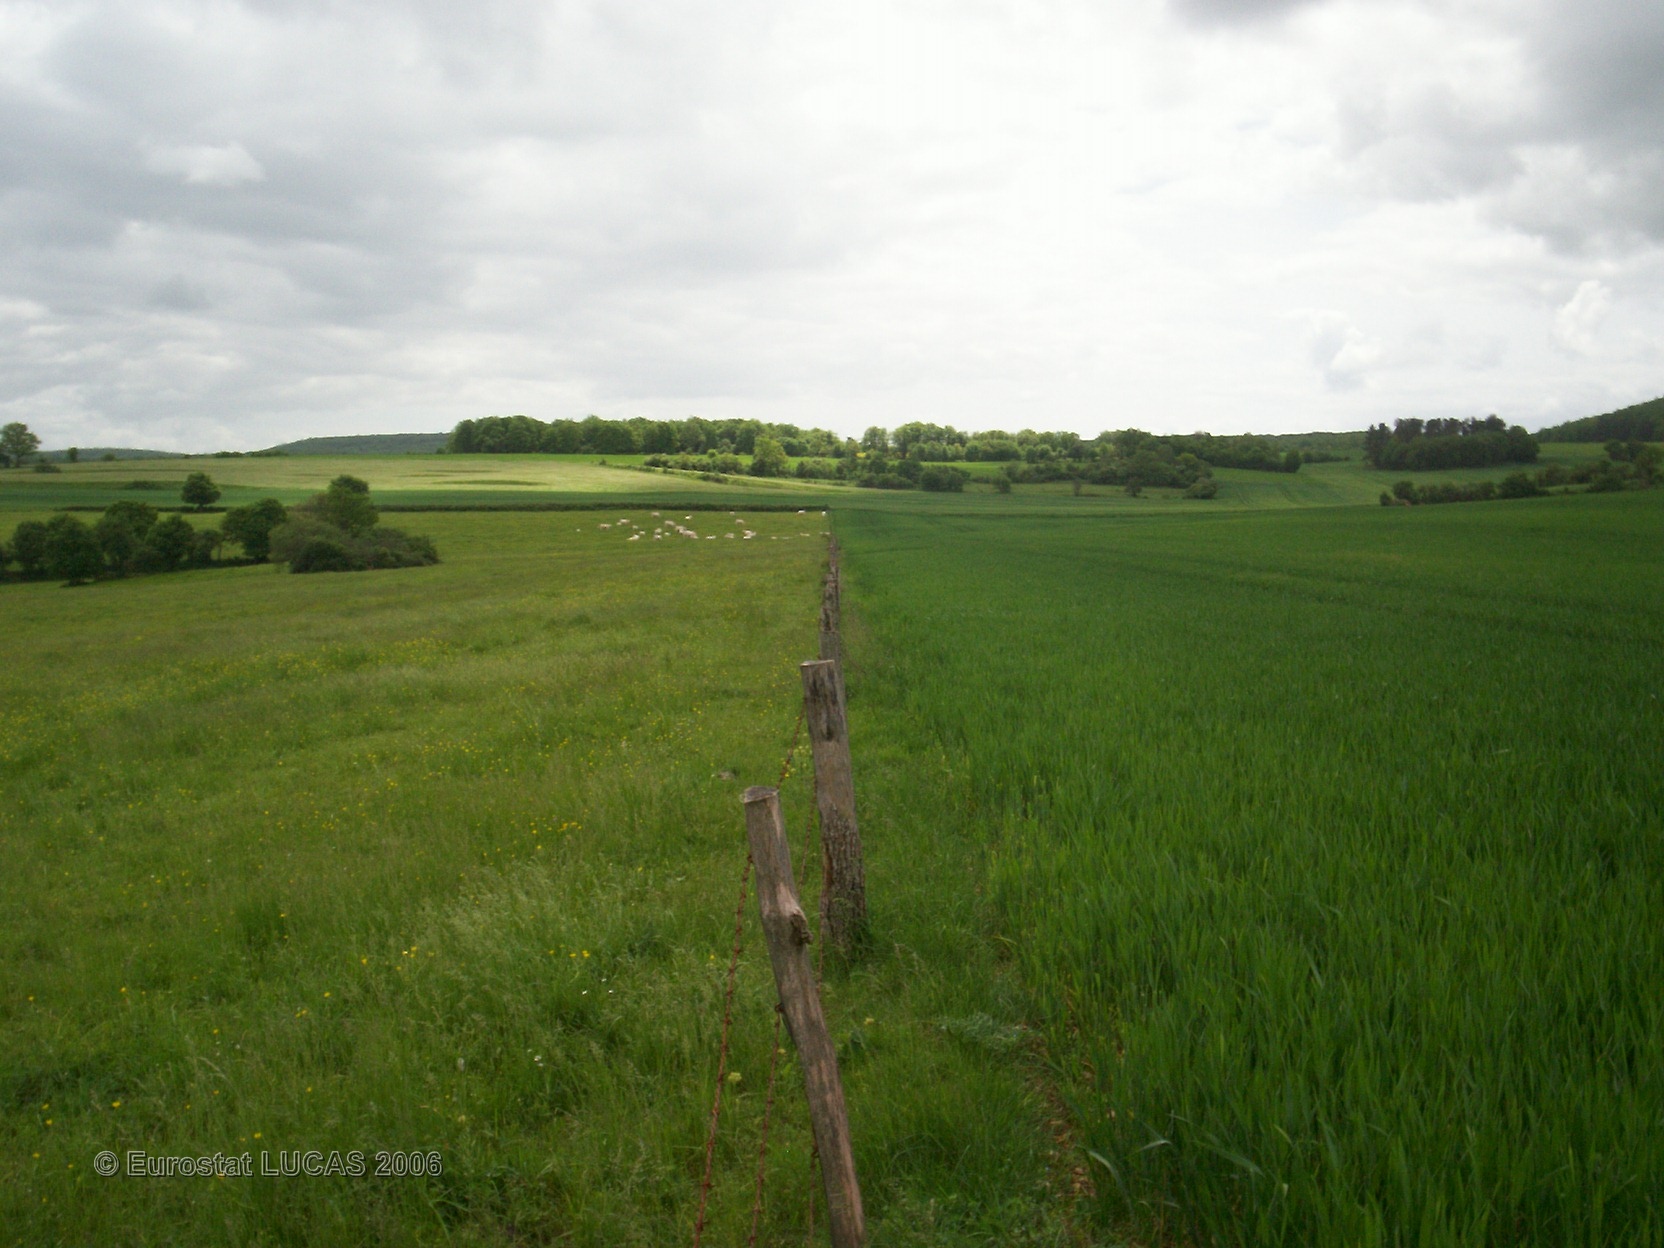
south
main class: Grassland
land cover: Grassland without tree/shrub cover
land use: Agriculture (excluding fallow land and kitchen gardens)
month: May
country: FR
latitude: 47.1574
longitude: 4.6847
